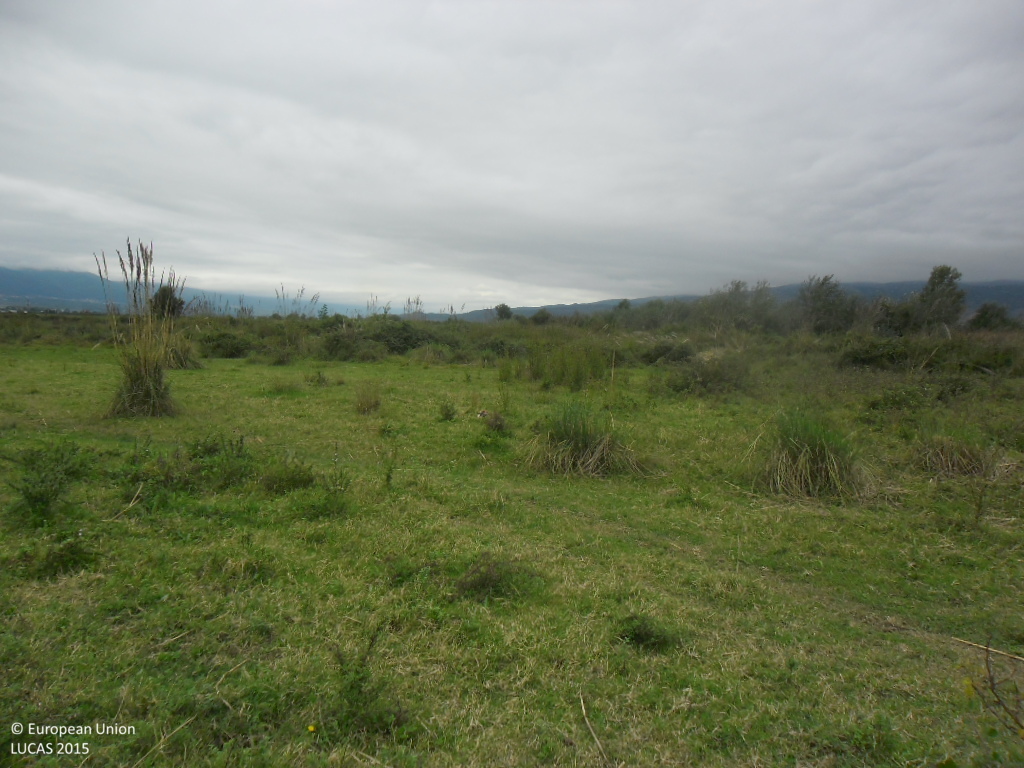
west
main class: Grassland
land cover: Grassland without tree/shrub cover
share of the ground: > 75 %
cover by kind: herbaceous plants 100 %
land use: Agriculture (excluding fallow land and kitchen gardens)
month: September
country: BG
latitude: 41.4328
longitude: 23.2436
